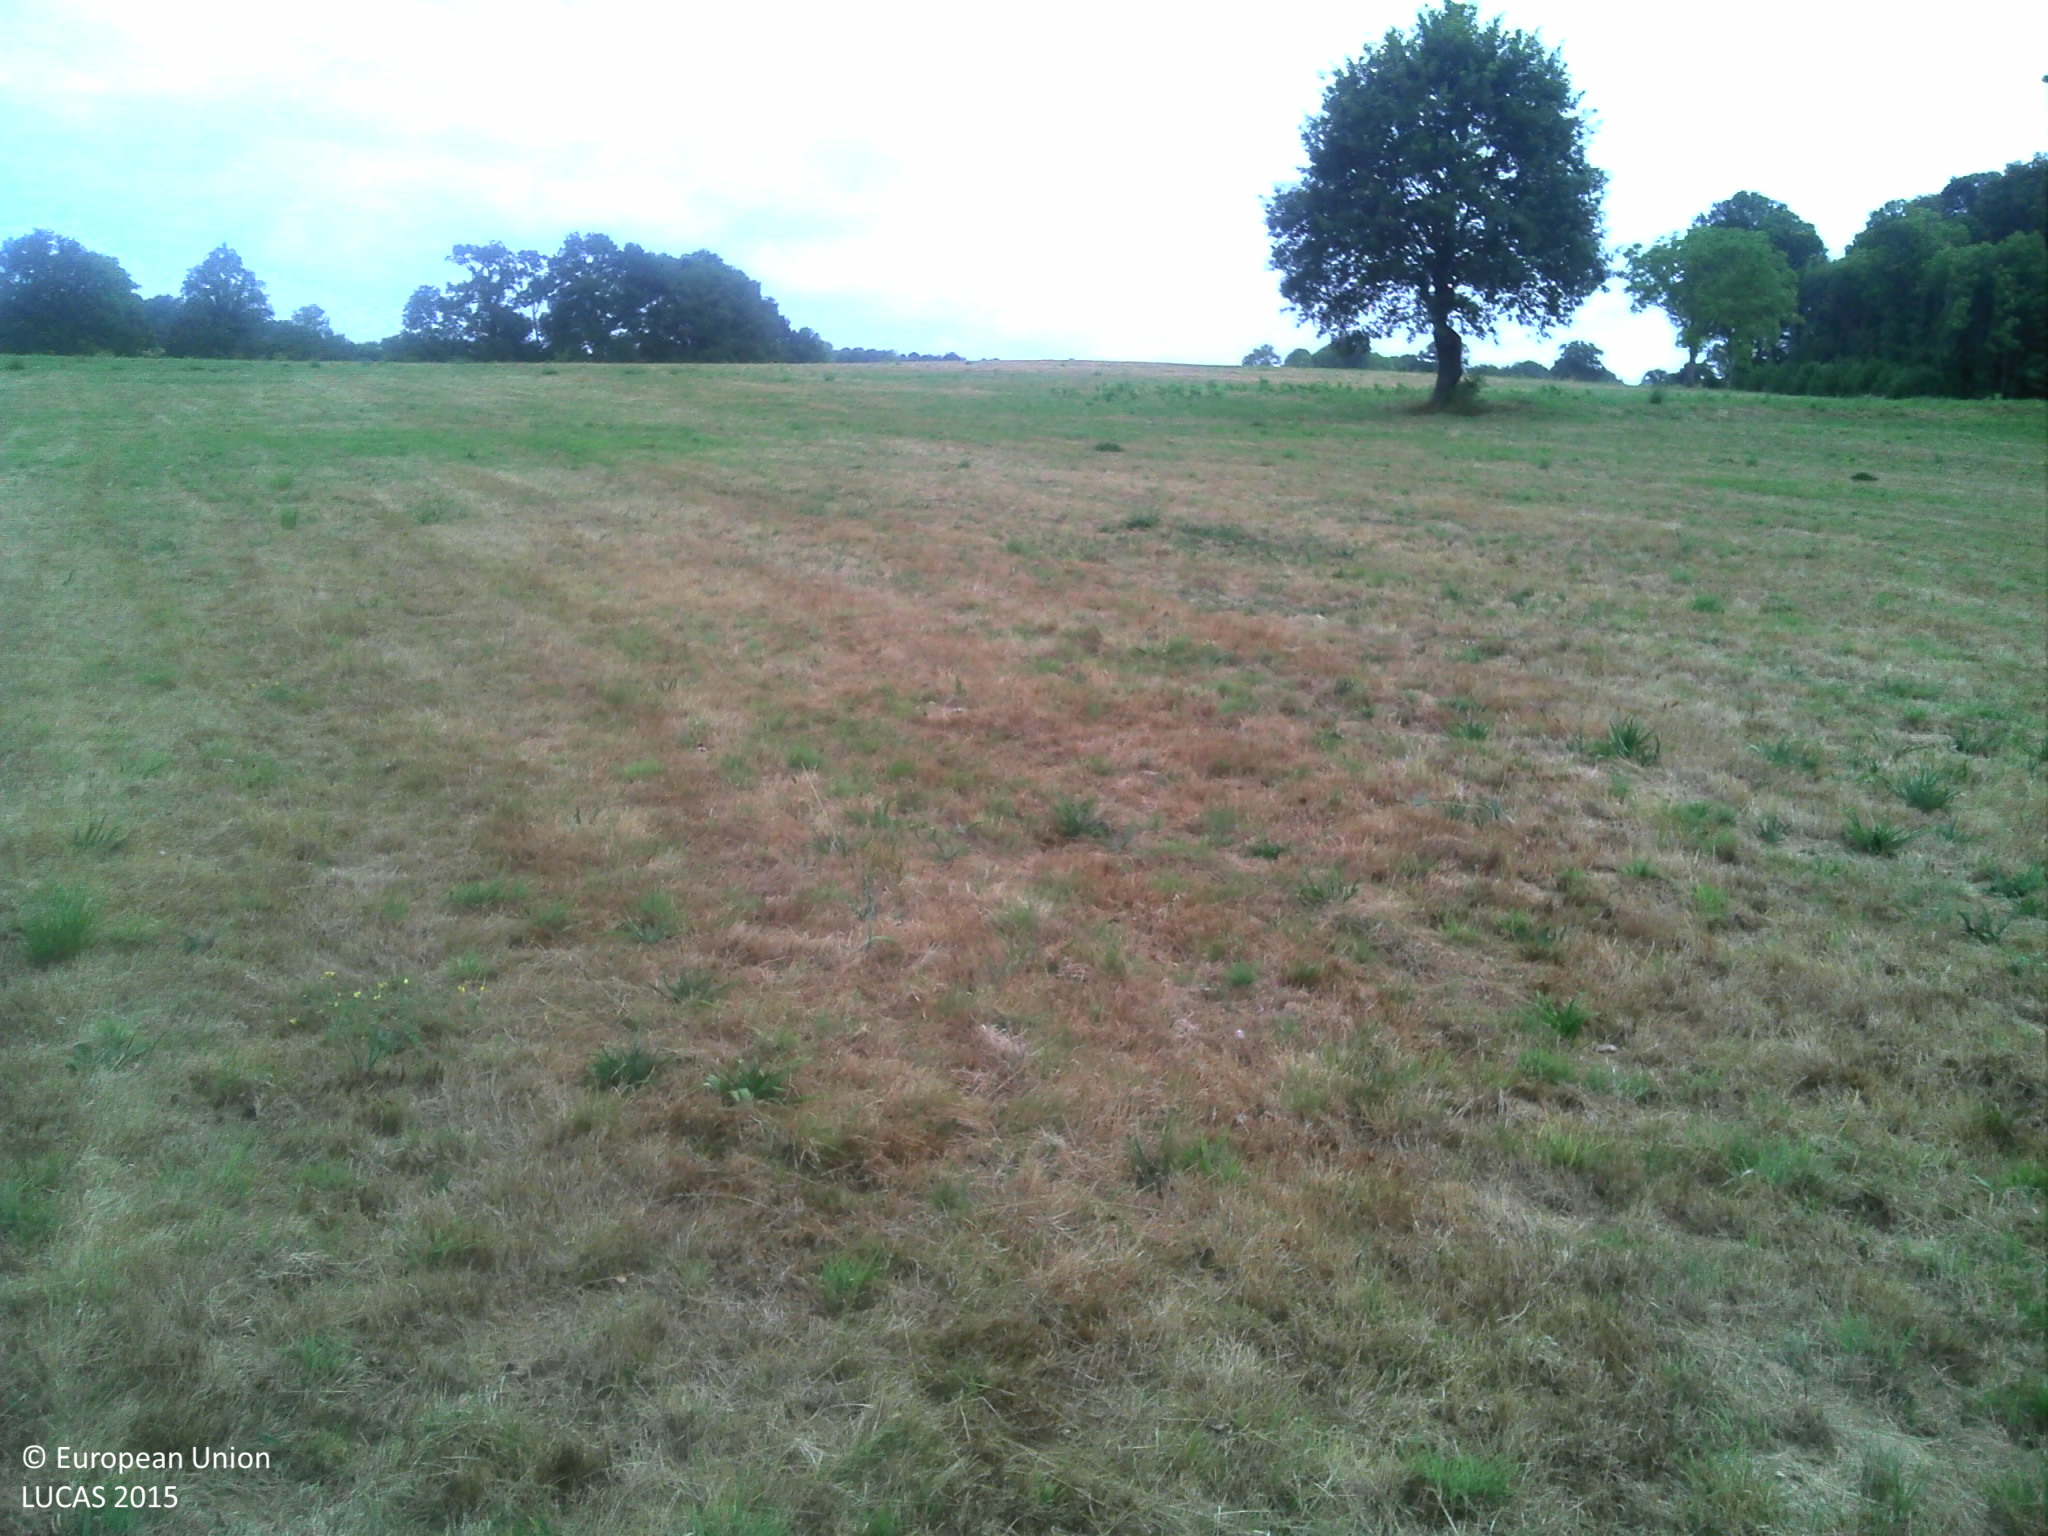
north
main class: Grassland
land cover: Grassland without tree/shrub cover
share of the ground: > 75 %
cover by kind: herbaceous plants 95 %, shrubs 5 %
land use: Agriculture (excluding fallow land and kitchen gardens)
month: July
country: FR
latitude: 45.3966
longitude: 1.4992
